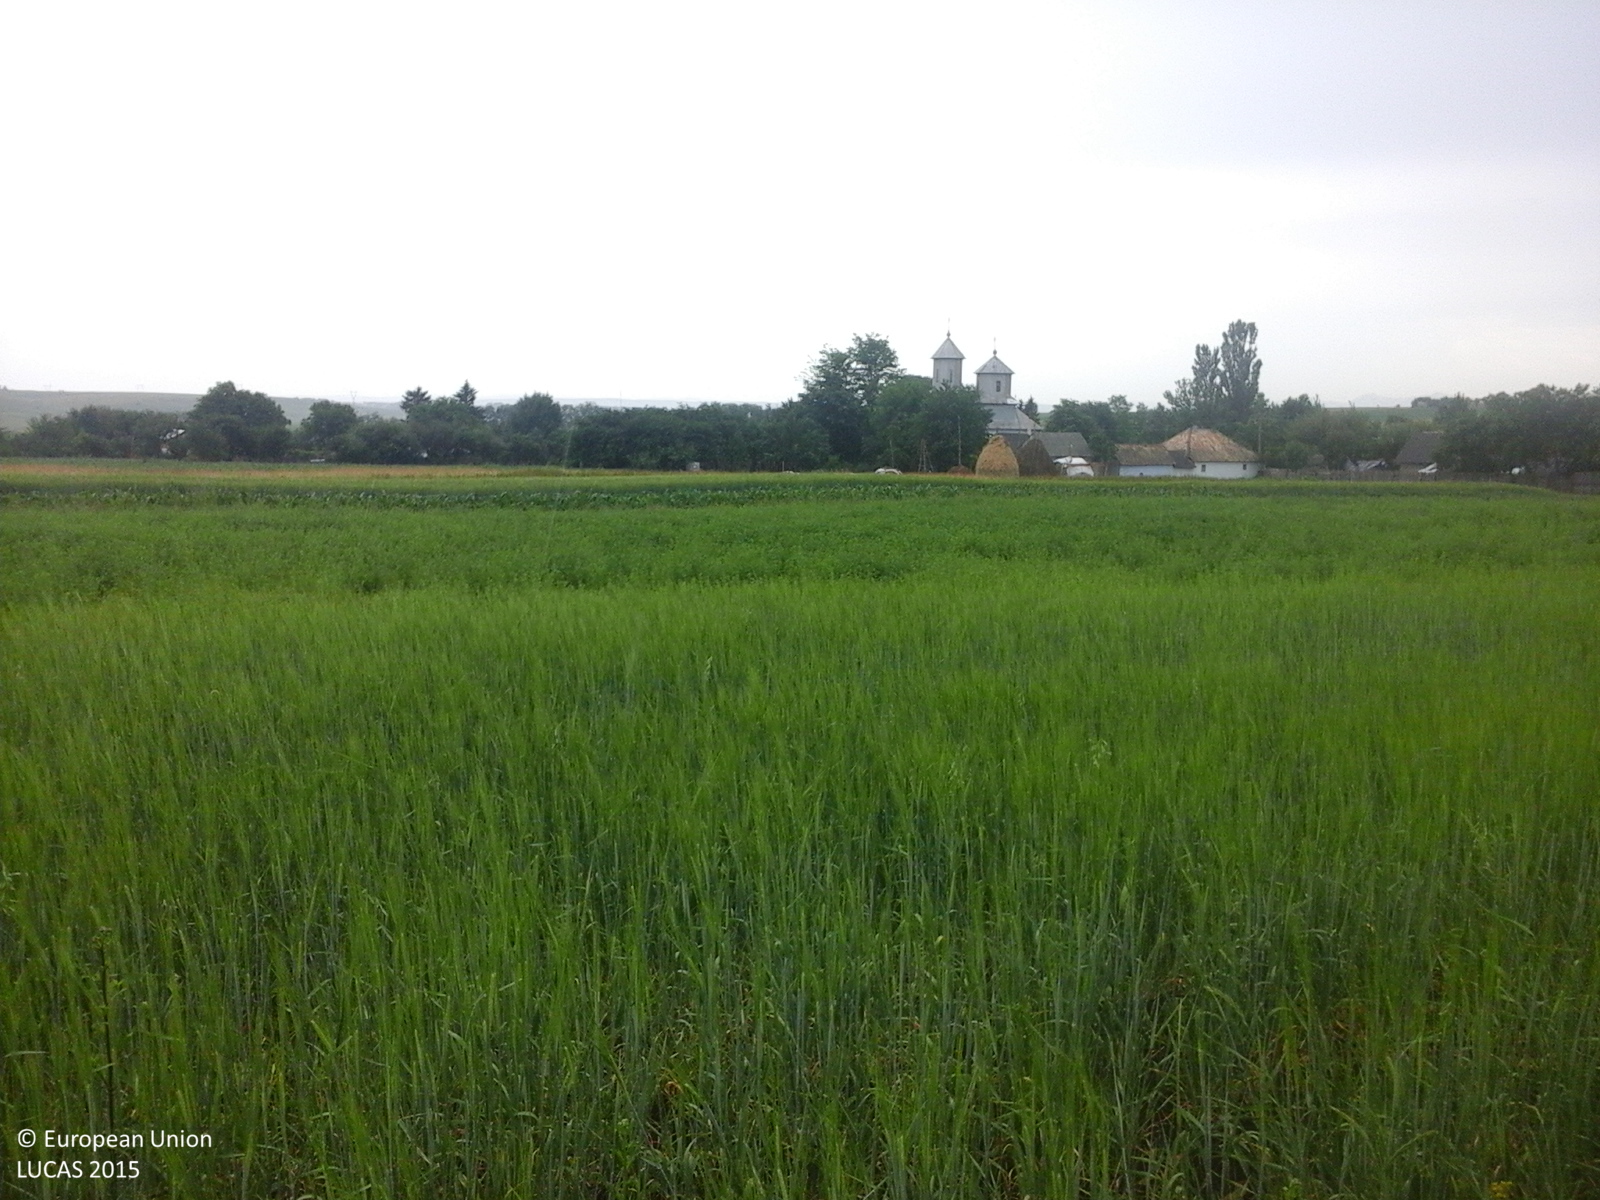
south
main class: Cropland
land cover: Barley
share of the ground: > 75 %
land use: Agriculture (excluding fallow land and kitchen gardens)
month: June
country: RO
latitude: 47.3383
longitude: 26.4853
